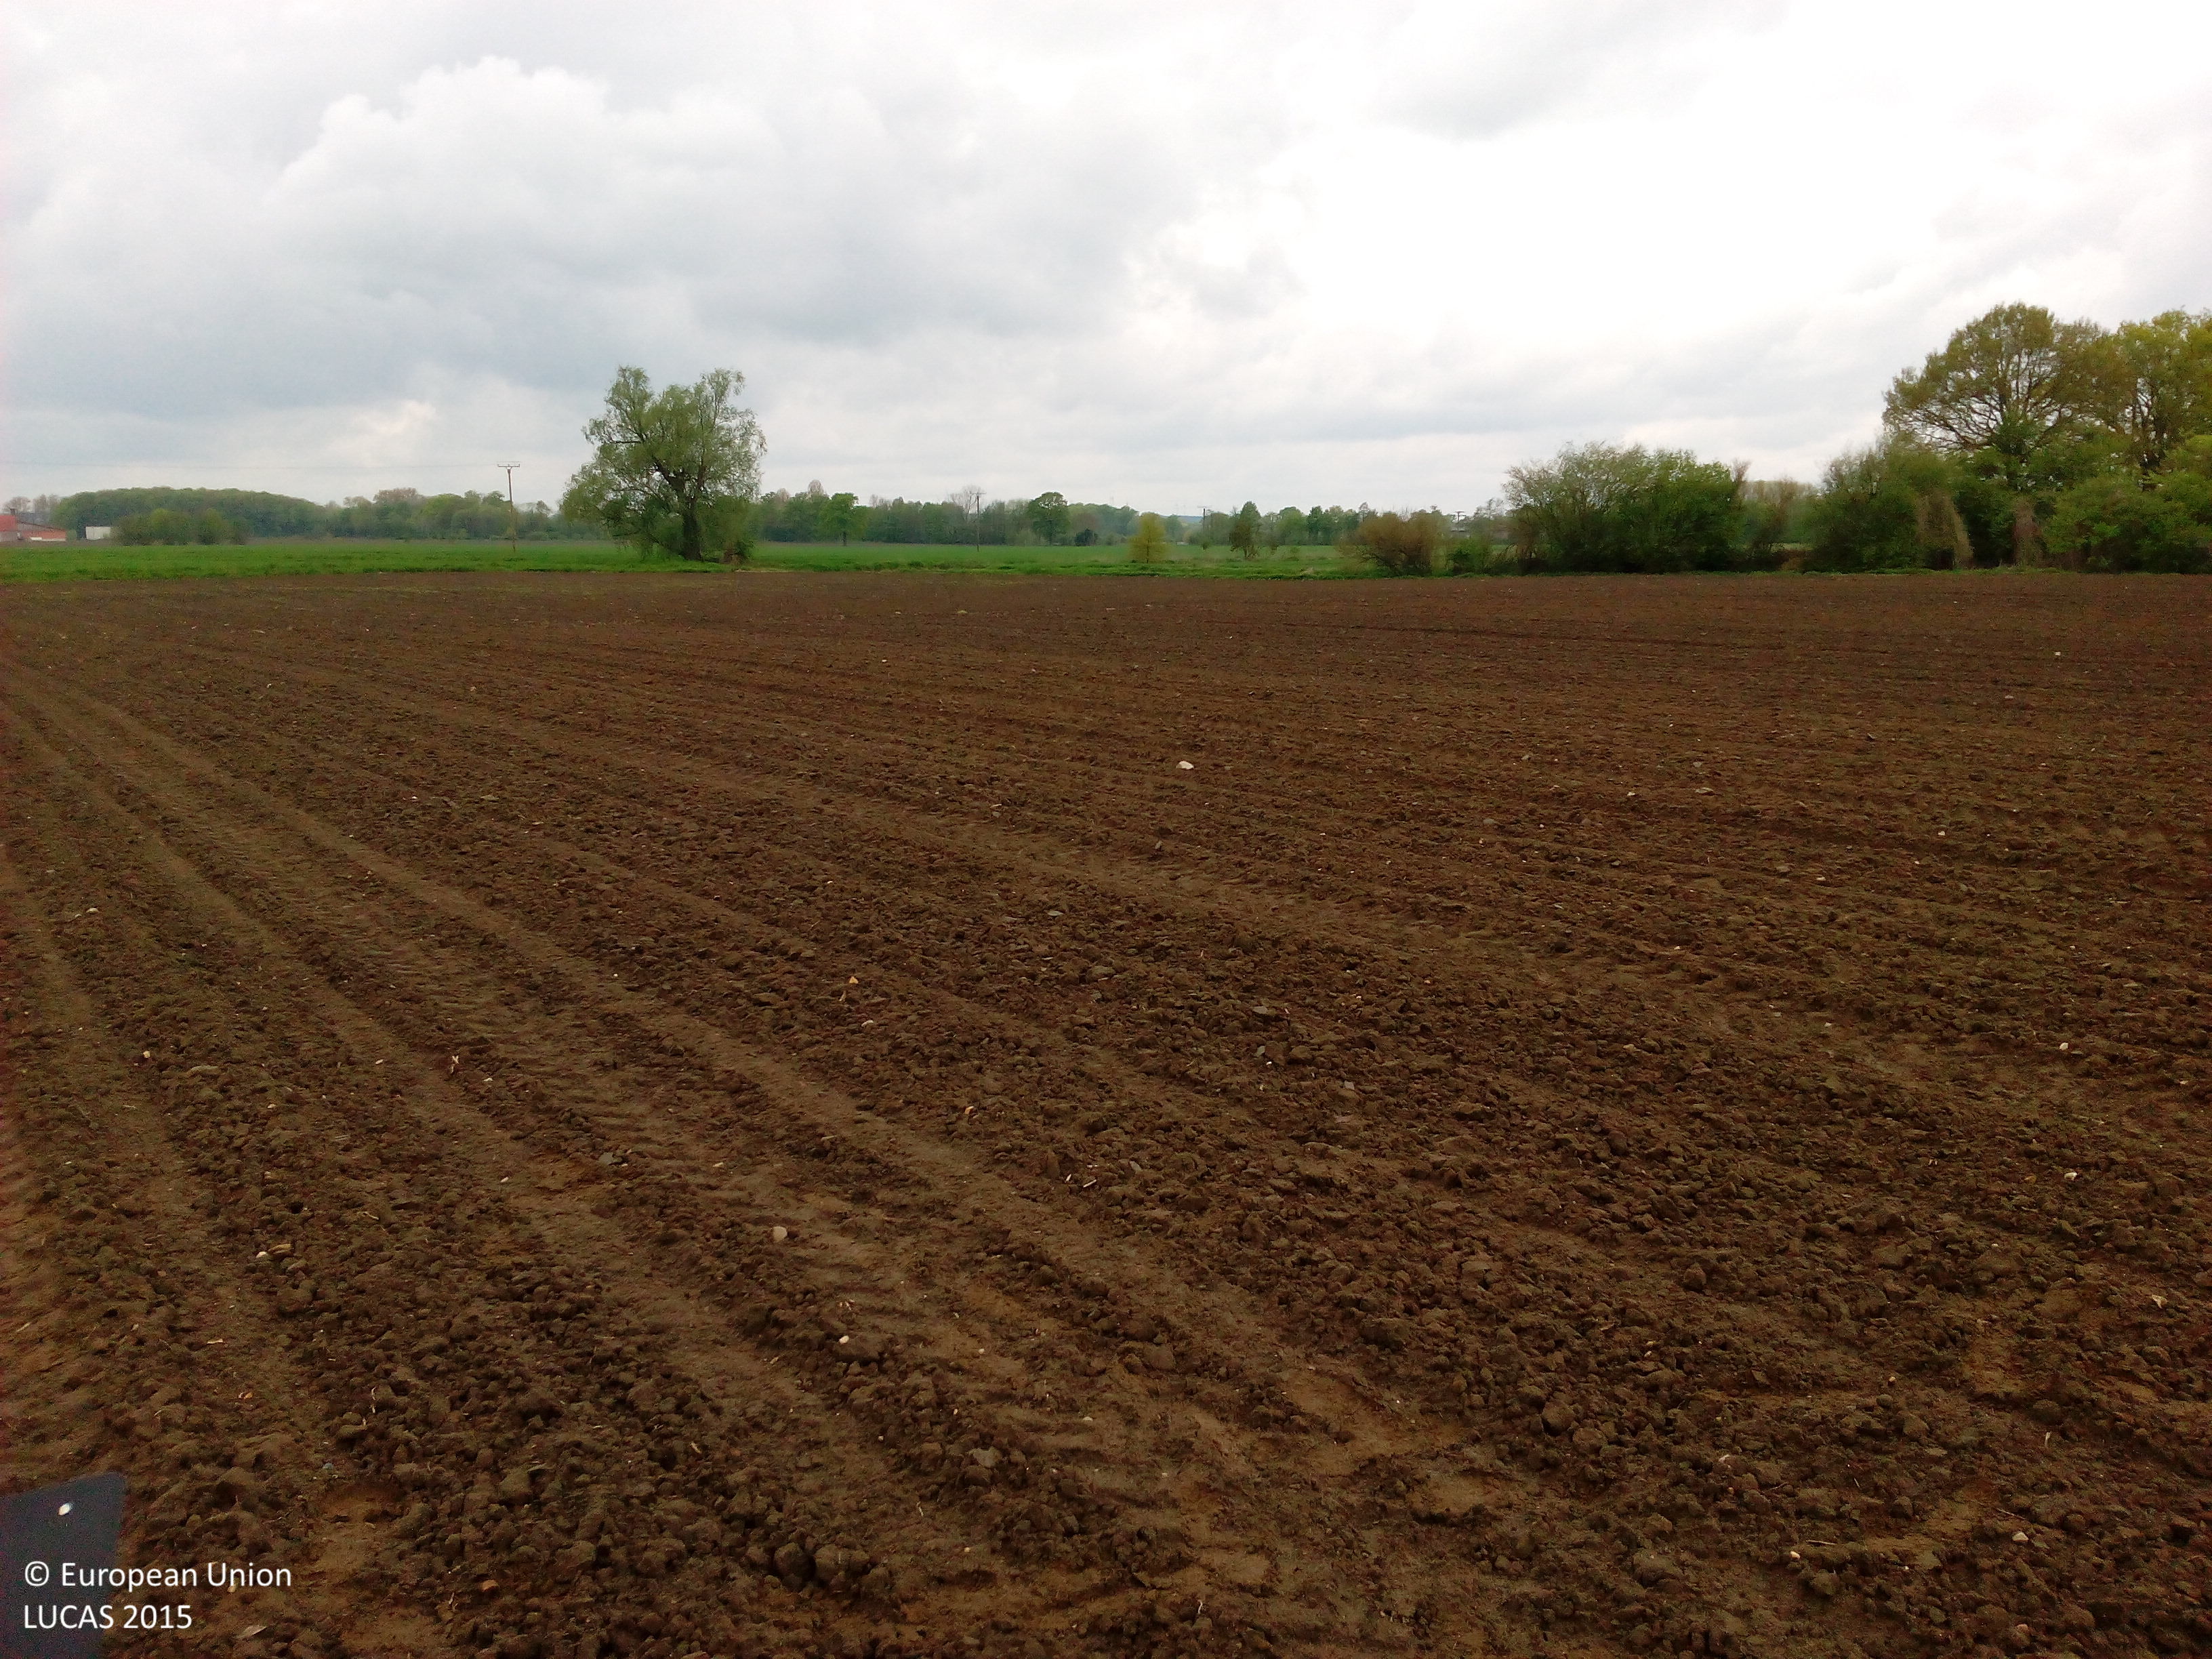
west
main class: Cropland
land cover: Maize
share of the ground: < 10 %
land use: Agriculture (excluding fallow land and kitchen gardens)
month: May
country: DE
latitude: 52.0790
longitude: 7.3884
